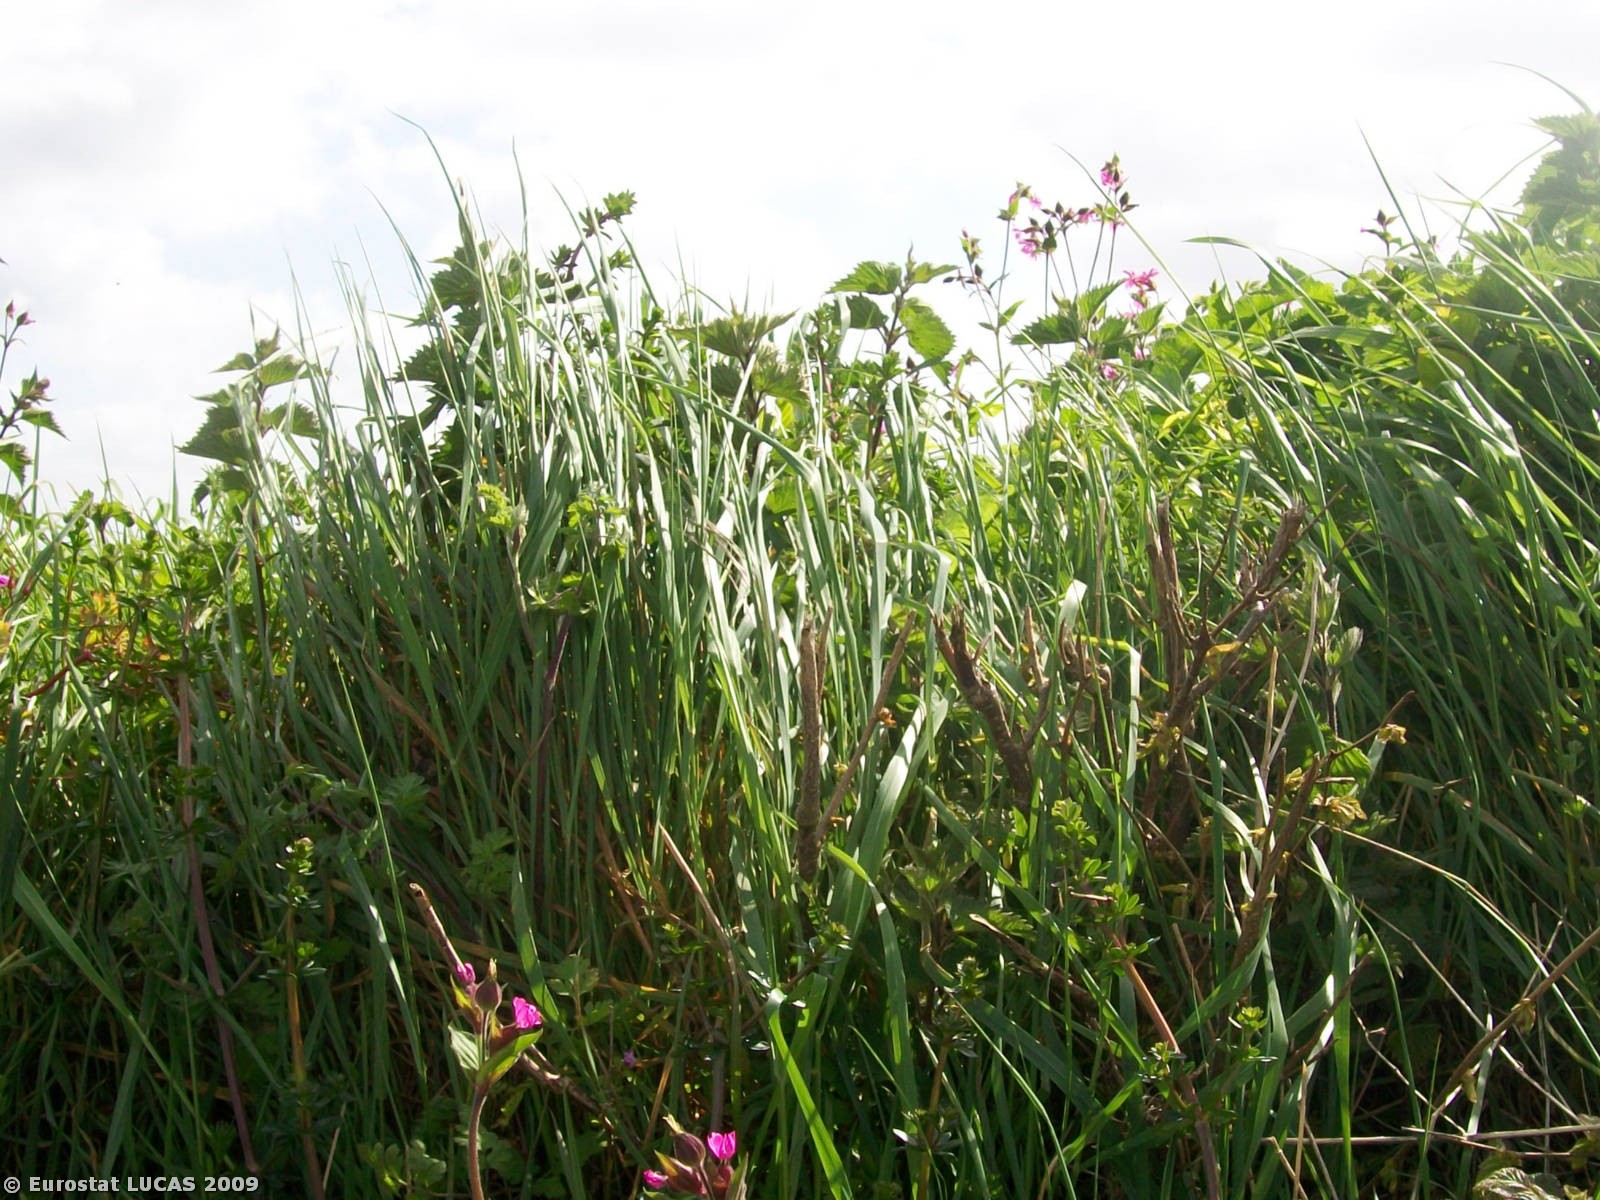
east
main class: Cropland
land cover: Maize
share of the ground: < 10 %
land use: Agriculture (excluding fallow land and kitchen gardens)
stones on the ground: 25 - 50 %
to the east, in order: Maize; Managed hedges; Common wheat; Managed hedges; Common wheat
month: May
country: GB
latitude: 50.4131
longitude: -4.2702
